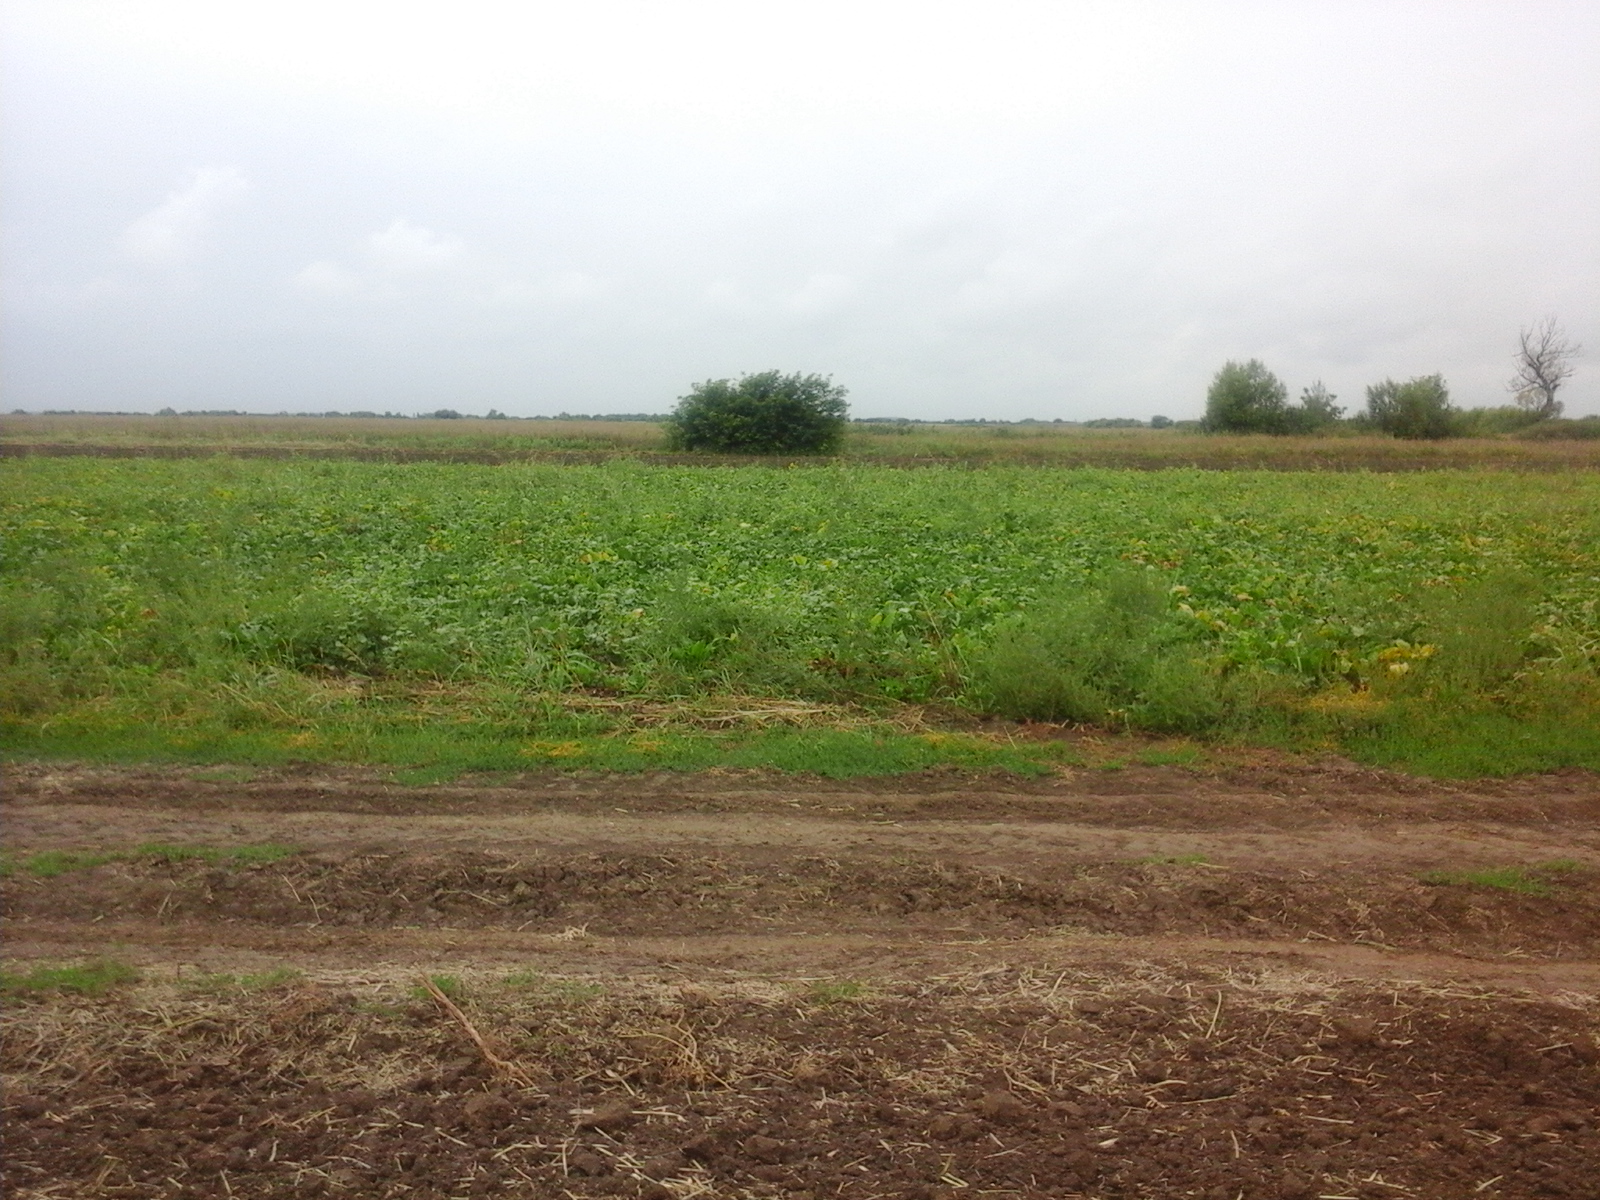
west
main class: Cropland
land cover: Common wheat
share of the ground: < 10 %
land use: Agriculture (excluding fallow land and kitchen gardens)
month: September
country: RO
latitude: 47.1753
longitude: 21.9083
